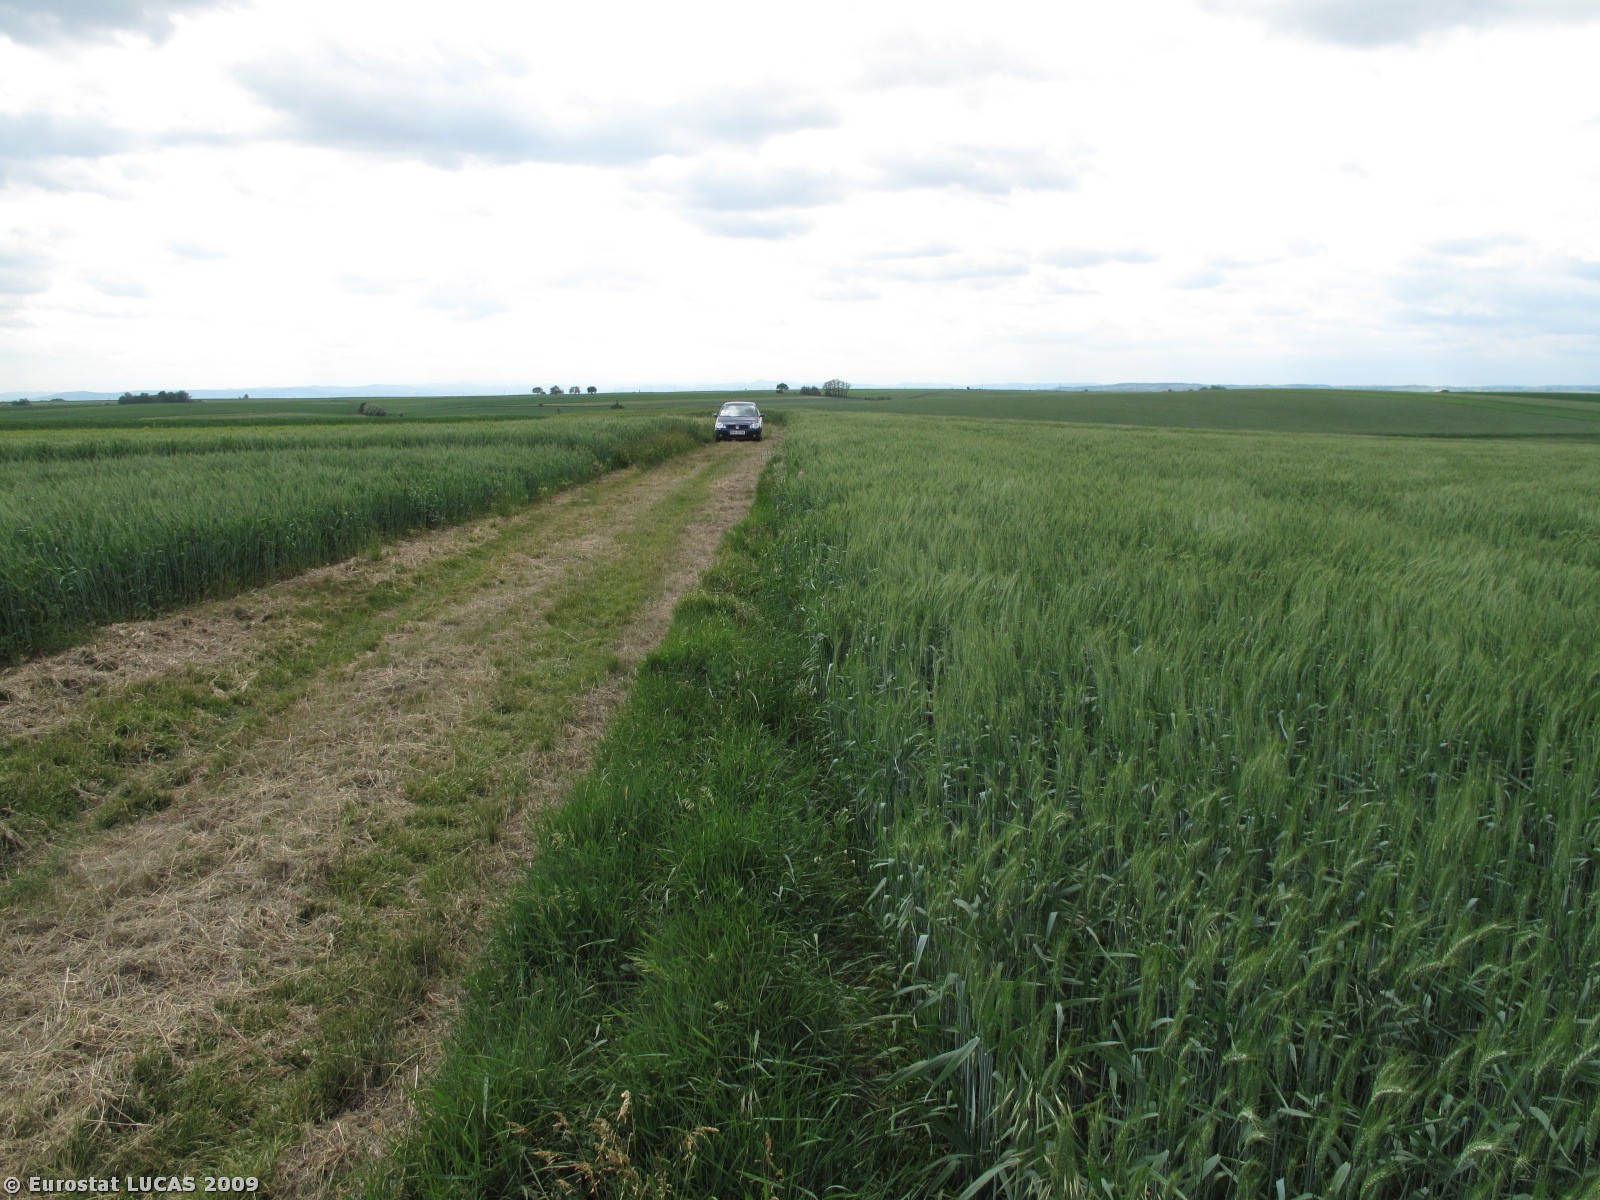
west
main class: Cropland
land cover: Triticale
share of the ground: > 75 %
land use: Agriculture (excluding fallow land and kitchen gardens)
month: May
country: AT
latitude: 48.4409
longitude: 15.9655
